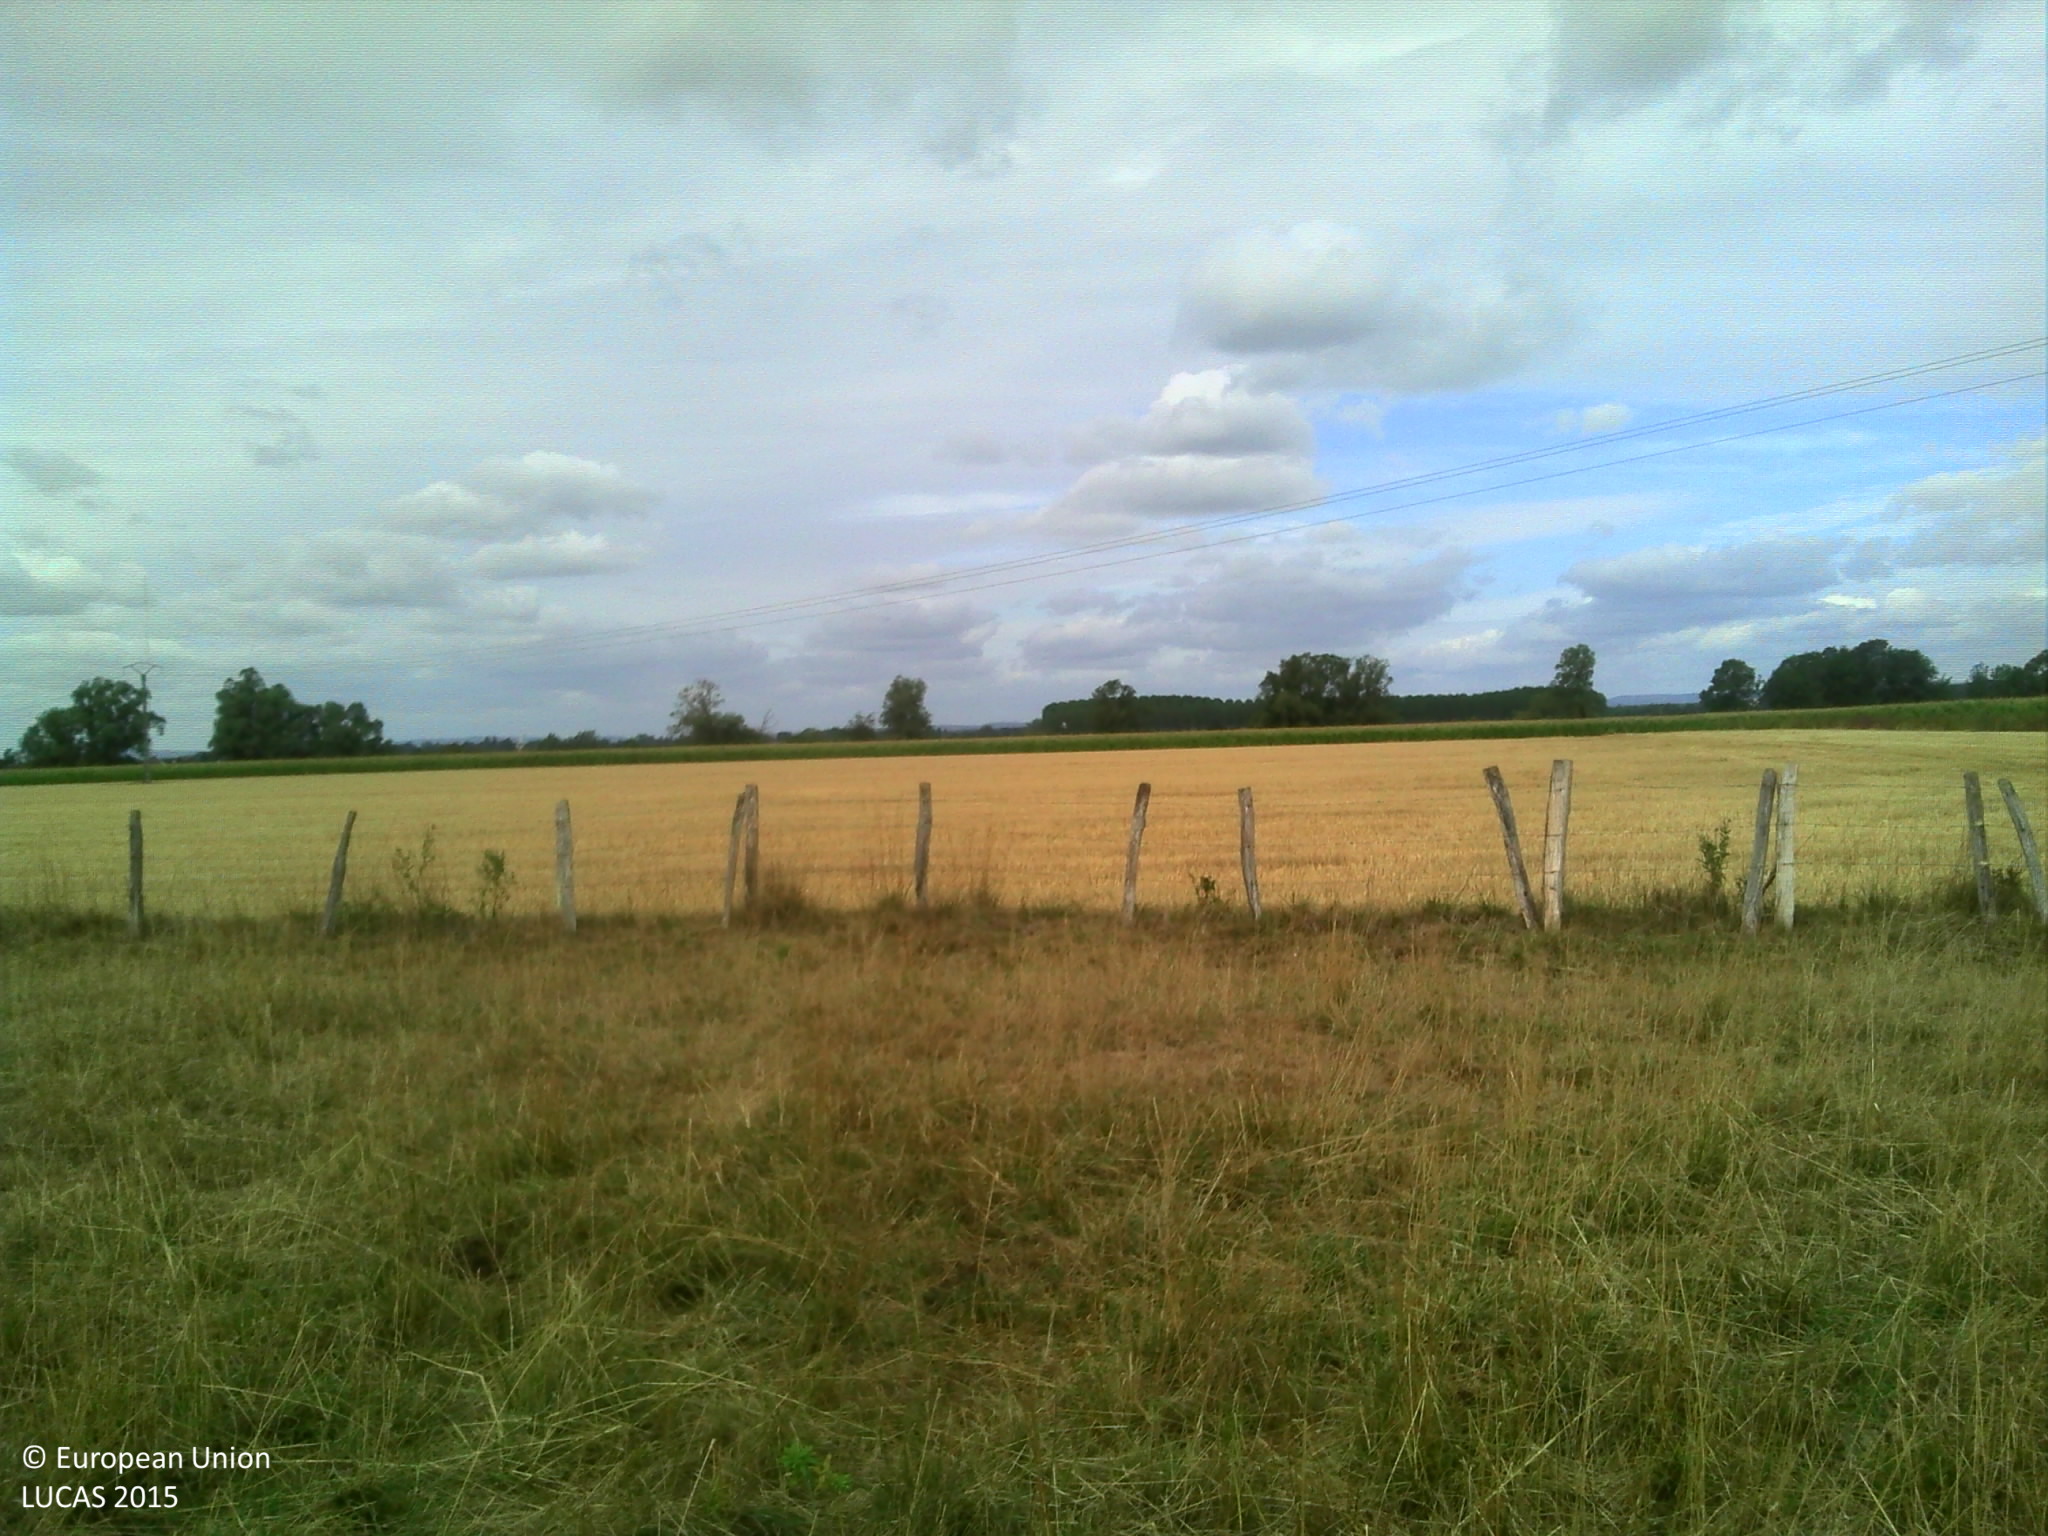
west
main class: Grassland
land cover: Grassland without tree/shrub cover
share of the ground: > 75 %
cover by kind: herbaceous plants 100 %
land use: Agriculture (excluding fallow land and kitchen gardens)
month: July
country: FR
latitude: 46.8839
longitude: 5.0015
